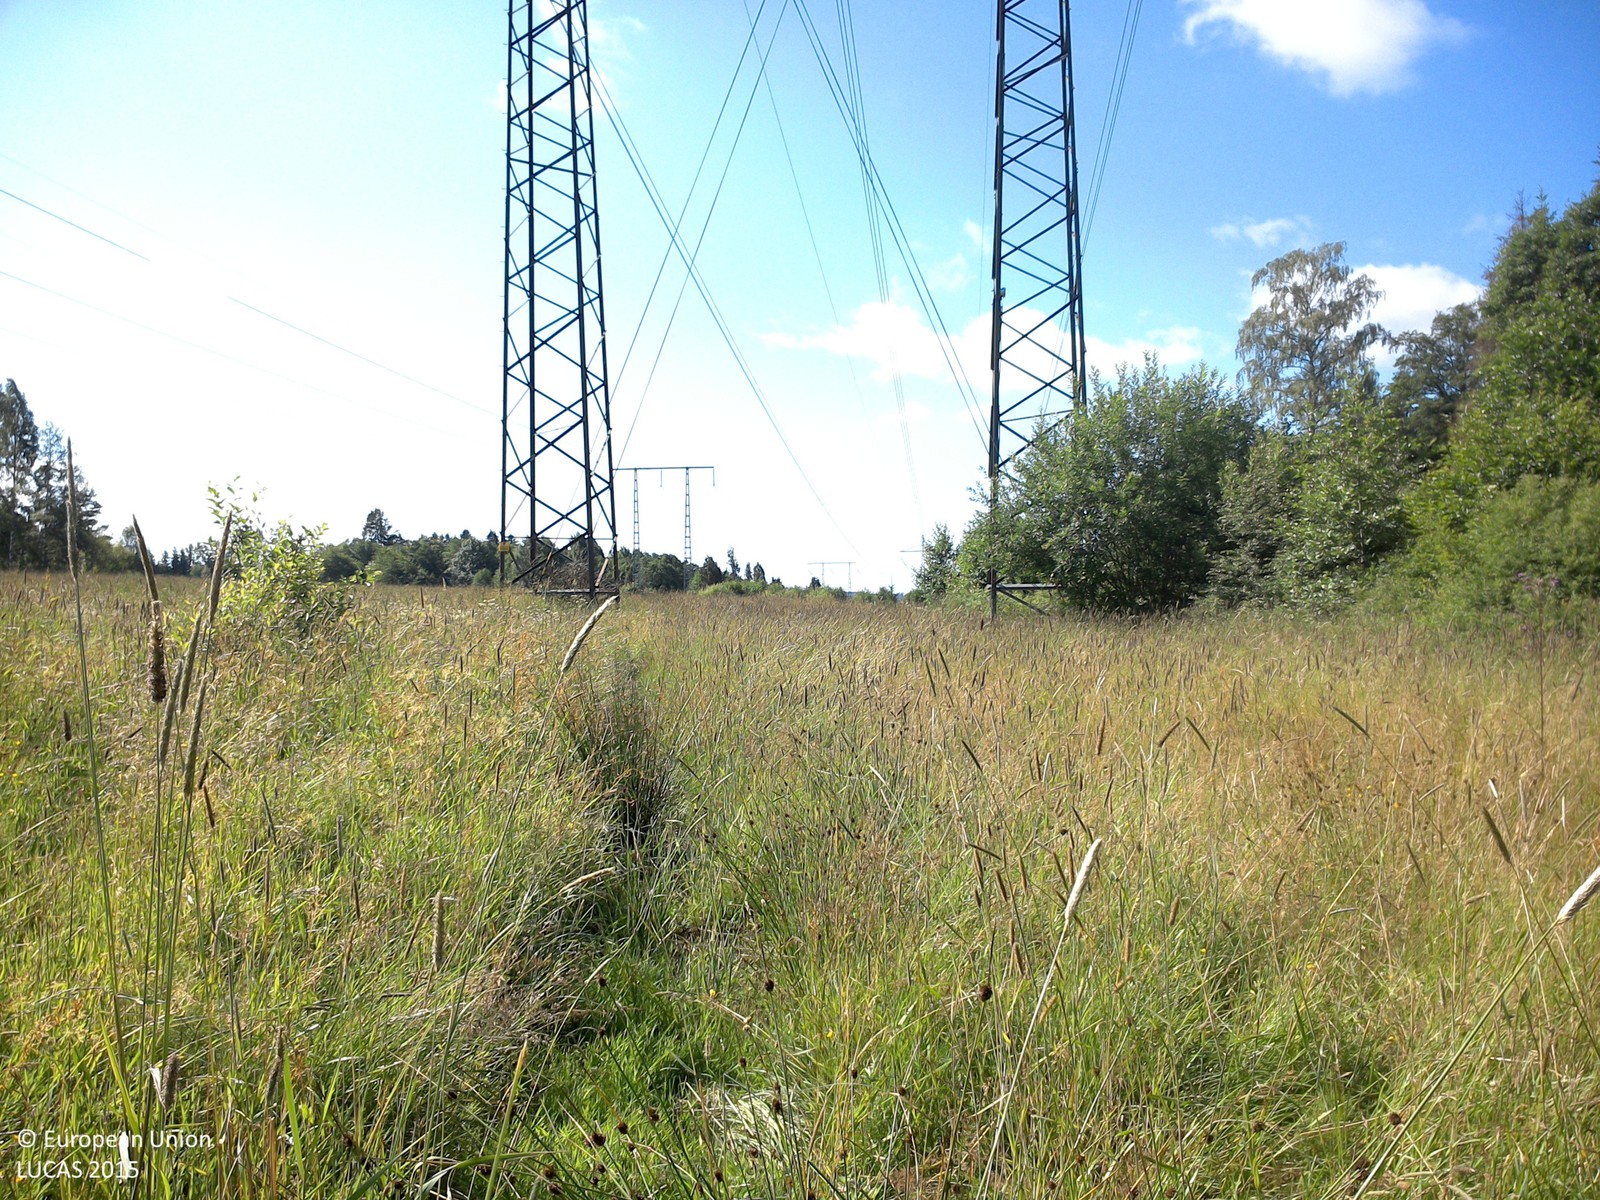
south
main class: Artificial land
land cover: Other artificial areas
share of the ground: > 75 %
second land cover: Temporary grasslands
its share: > 75 %
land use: Electricity, gas and thermal power distribution
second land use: Agriculture (excluding fallow land and kitchen gardens)
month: July
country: SE
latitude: 57.9903
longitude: 14.7816
